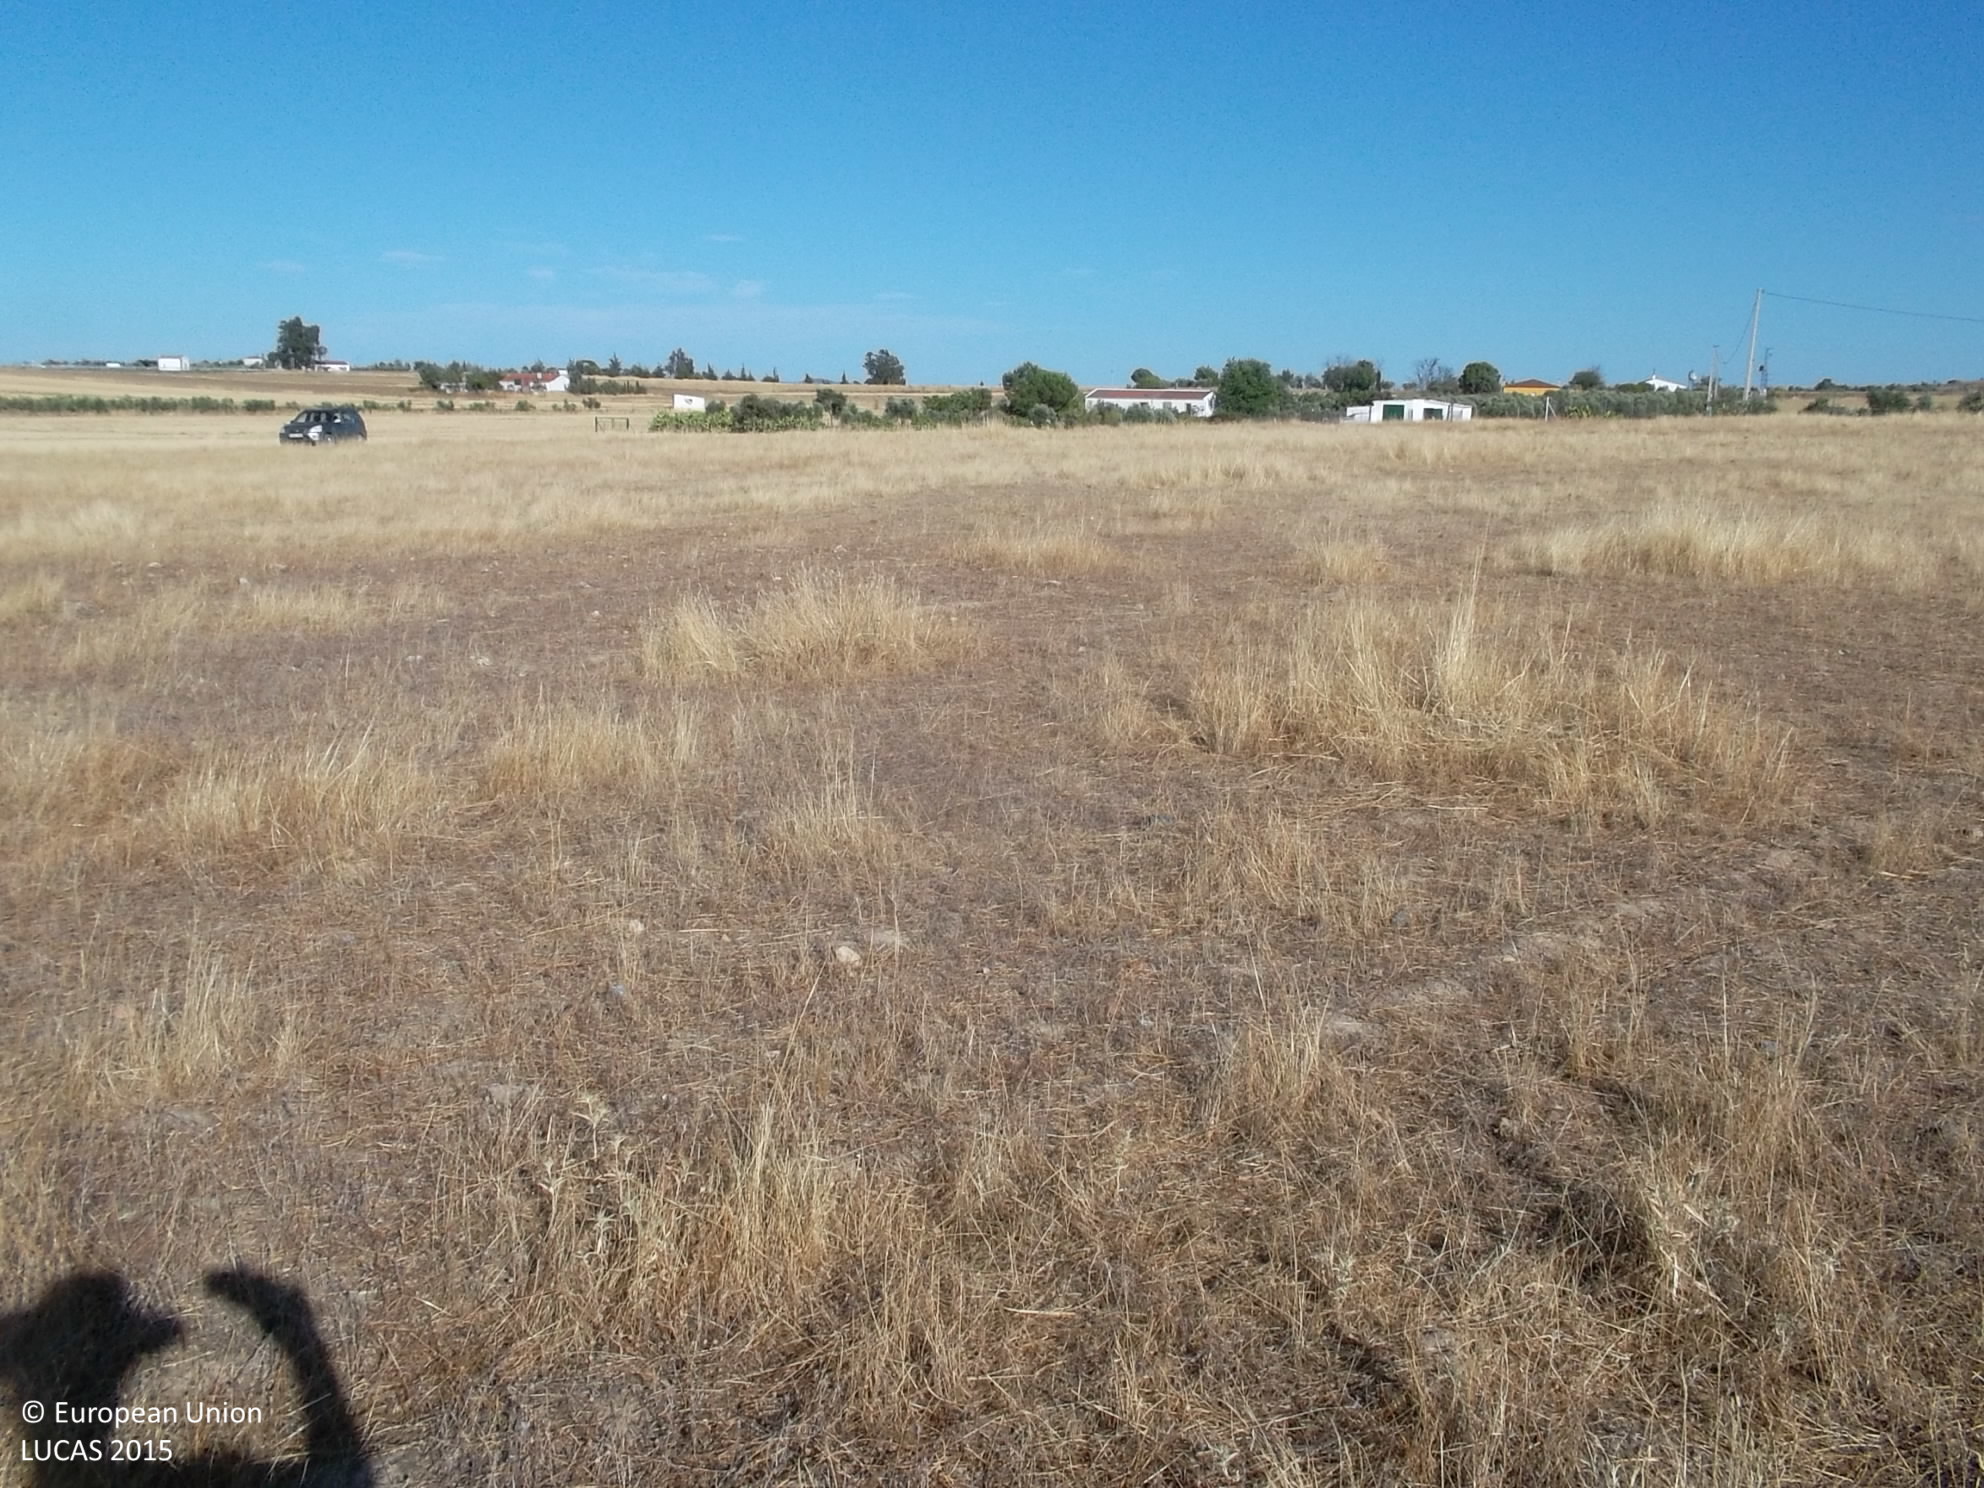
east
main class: Grassland
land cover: Spontaneously vegetated surfaces
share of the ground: > 75 %
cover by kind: herbaceous plants 100 %
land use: Agriculture (excluding fallow land and kitchen gardens)
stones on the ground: 10 - 25 %
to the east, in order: Spontaneously vegetated surfaces; Common wheat; Tracks; Common wheat; Tracks; Oats; Fences; Olive groves
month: July
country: ES
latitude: 38.2793
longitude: -5.6845
